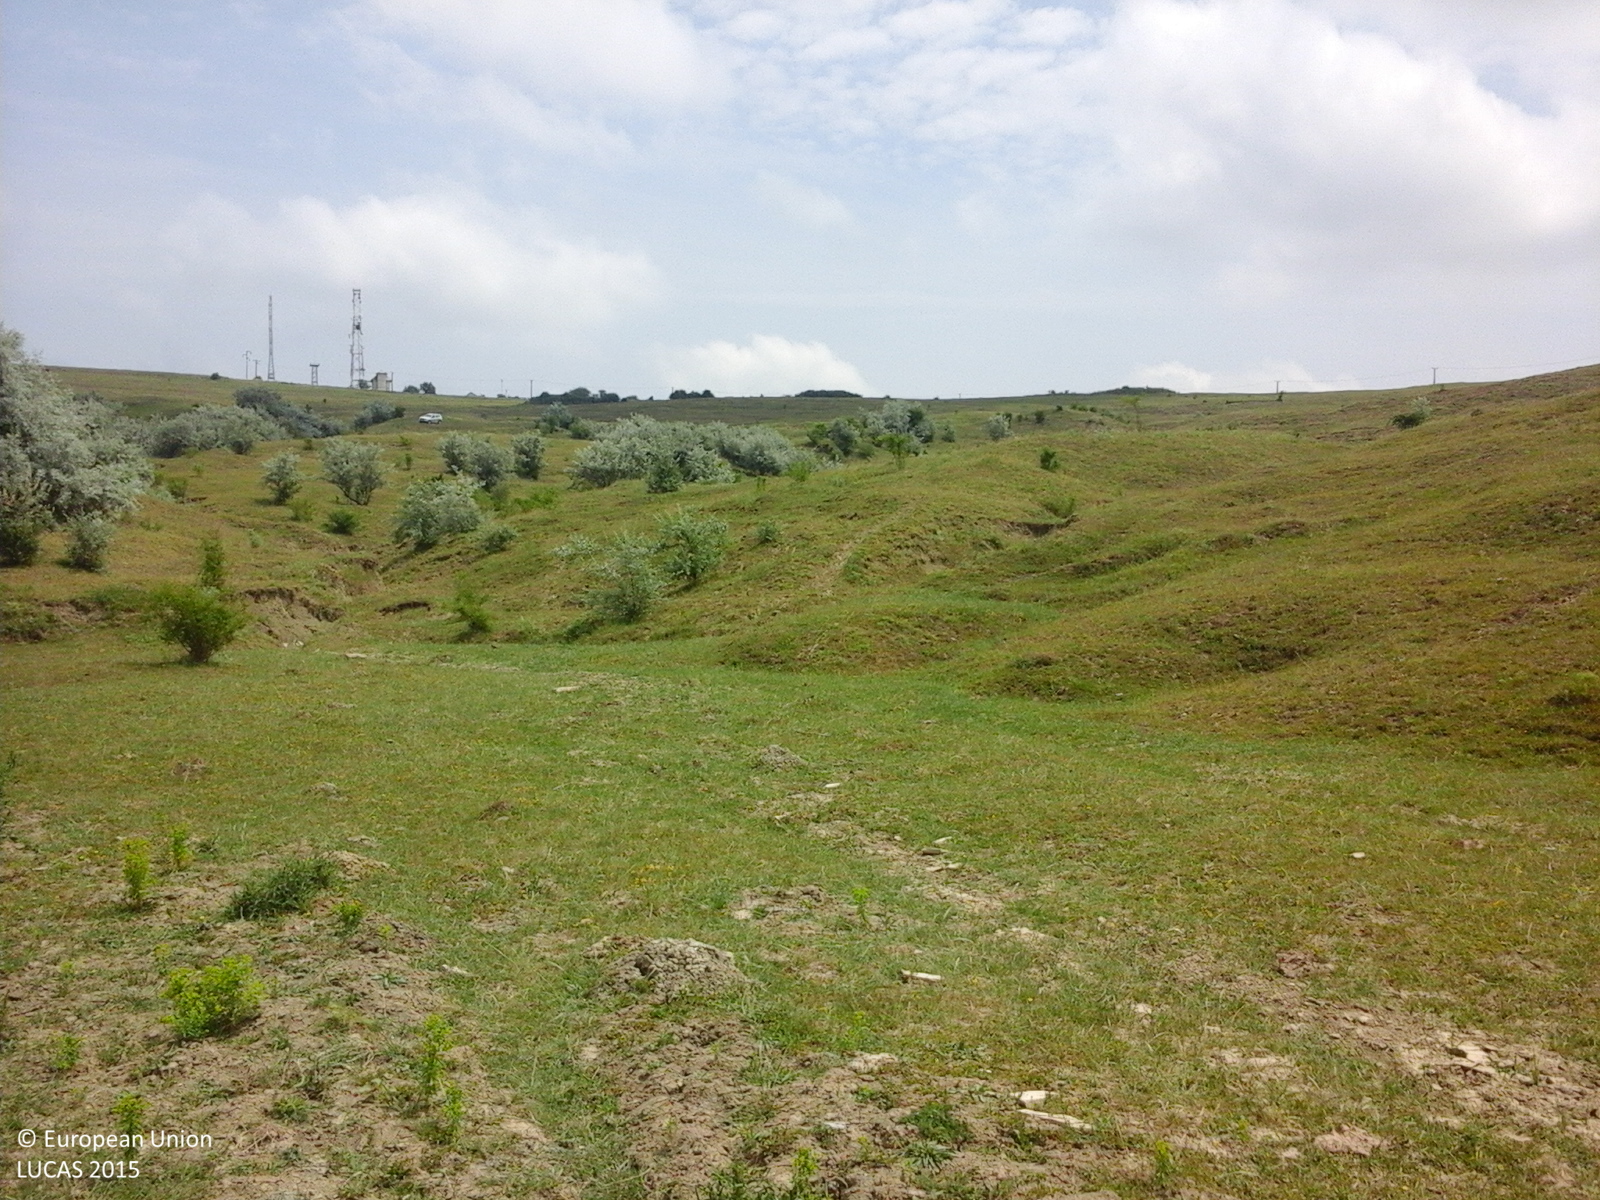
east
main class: Grassland
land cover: Grassland with sparse tree/shrub cover
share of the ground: > 75 %
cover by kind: herbaceous plants 85 %, shrubs 10 %, broadleaved forest trees 5 %
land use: Agriculture (excluding fallow land and kitchen gardens)
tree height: < 5 m
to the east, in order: Grassland with sparse tree/shrub cover
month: June
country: RO
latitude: 47.7645
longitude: 26.4603
